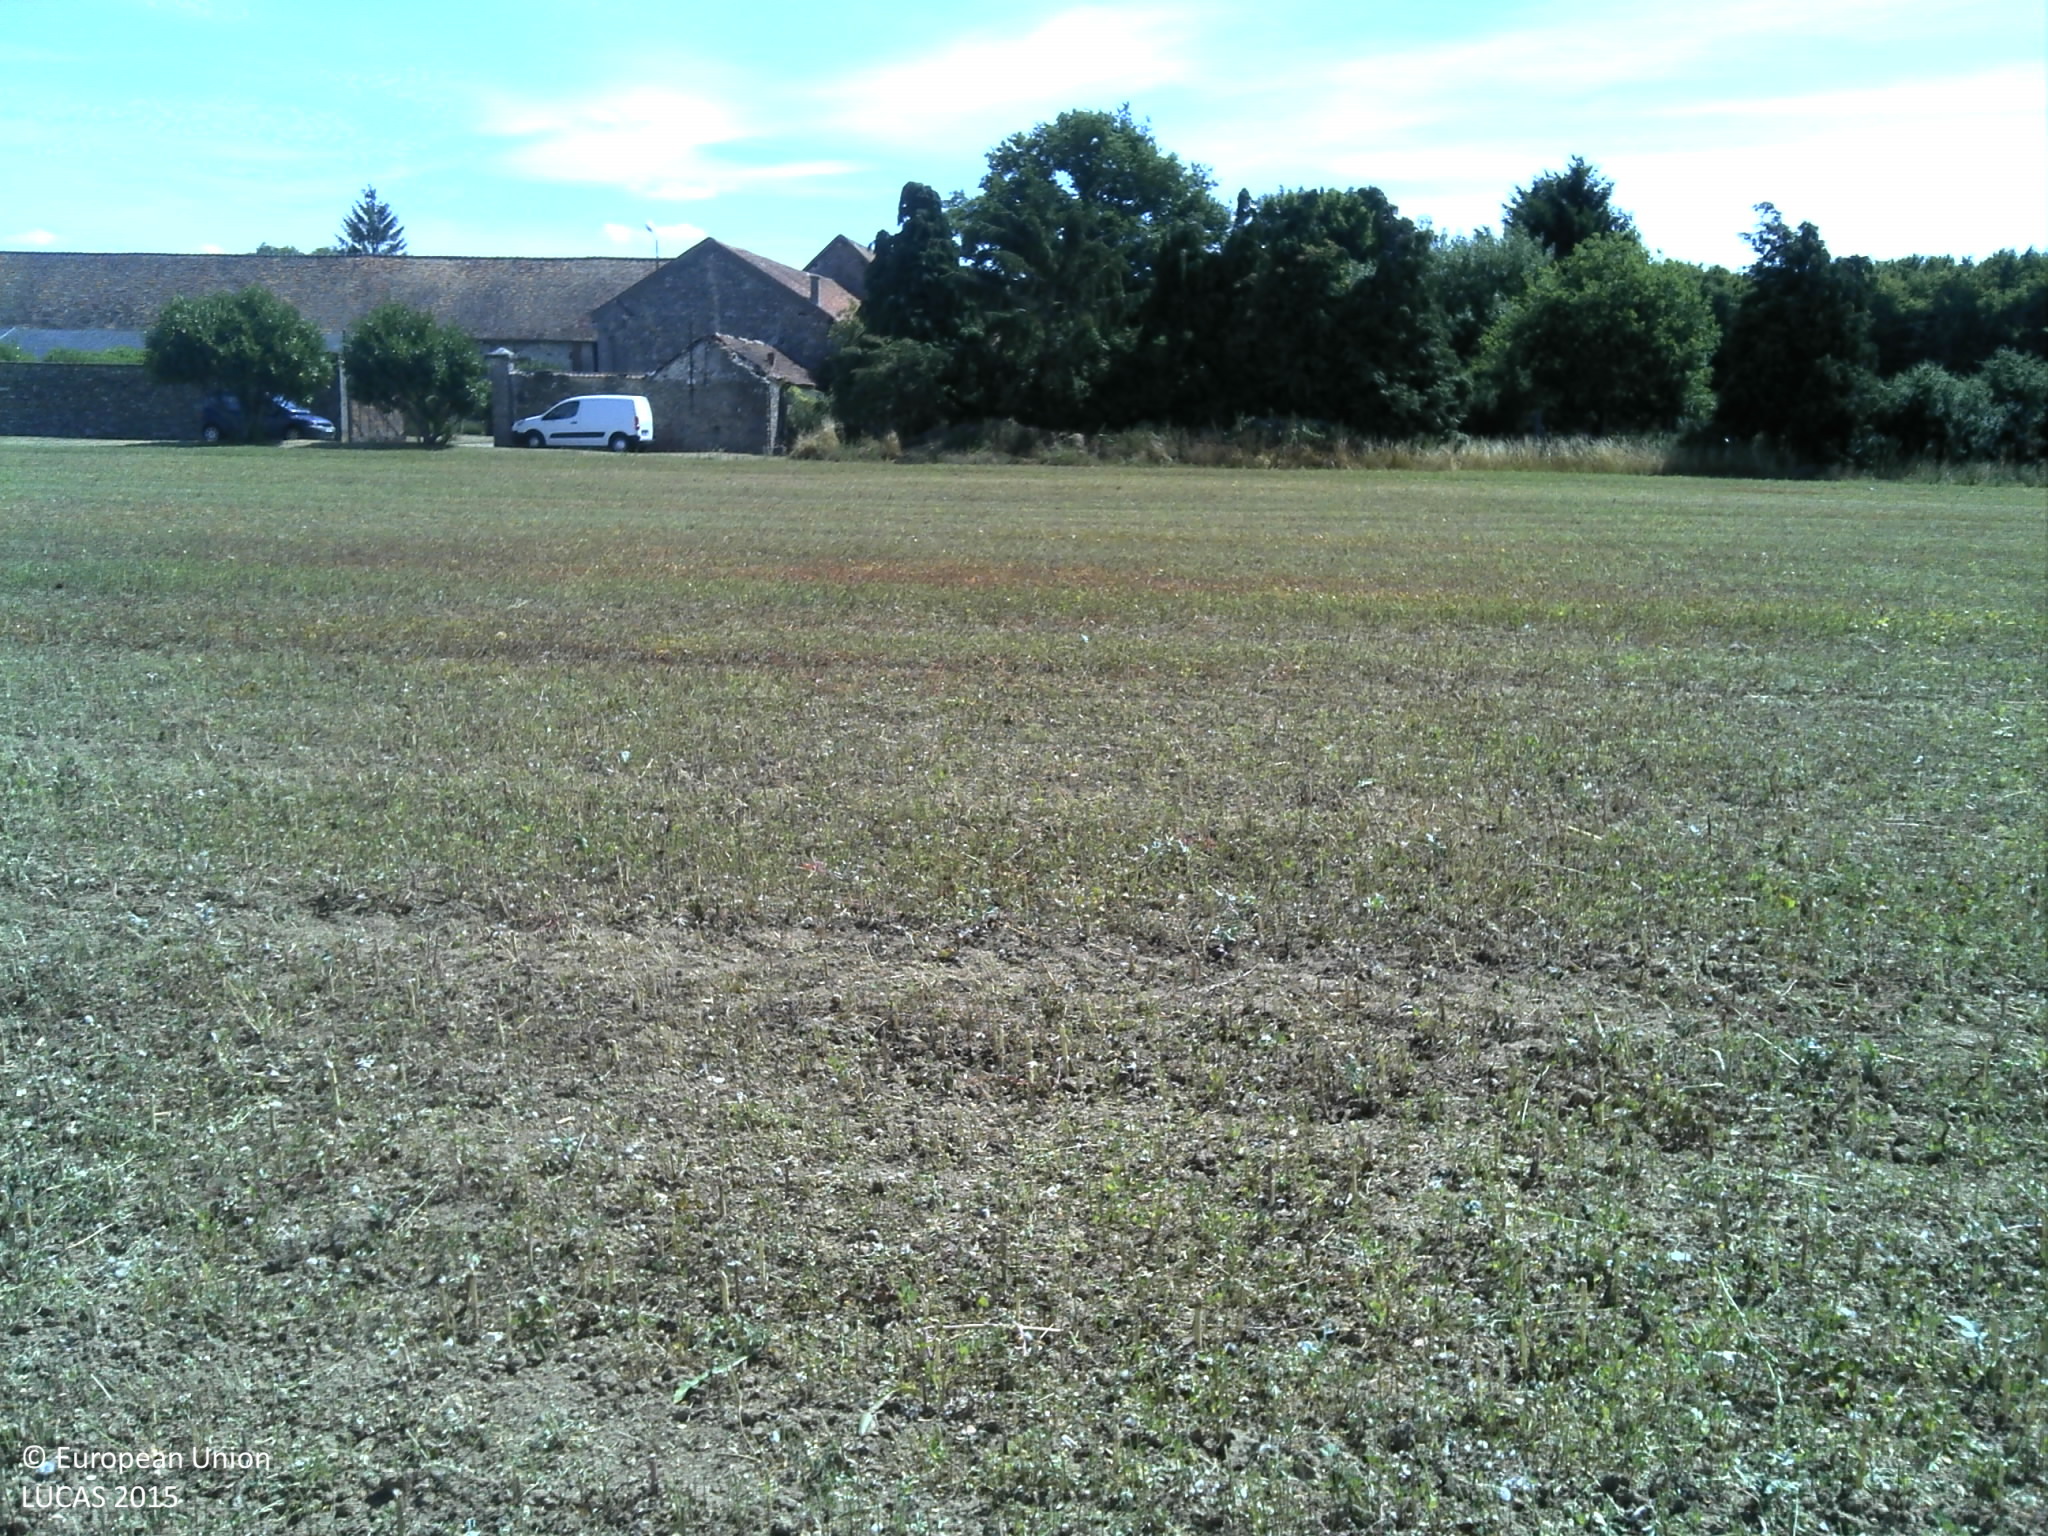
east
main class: Cropland
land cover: Temporary grasslands
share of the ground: > 75 %
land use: Agriculture (excluding fallow land and kitchen gardens)
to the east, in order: Temporary grasslands; Artificial constructions in urban areas; Broadleaved woodland
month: July
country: FR
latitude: 48.5558
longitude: 1.8699
